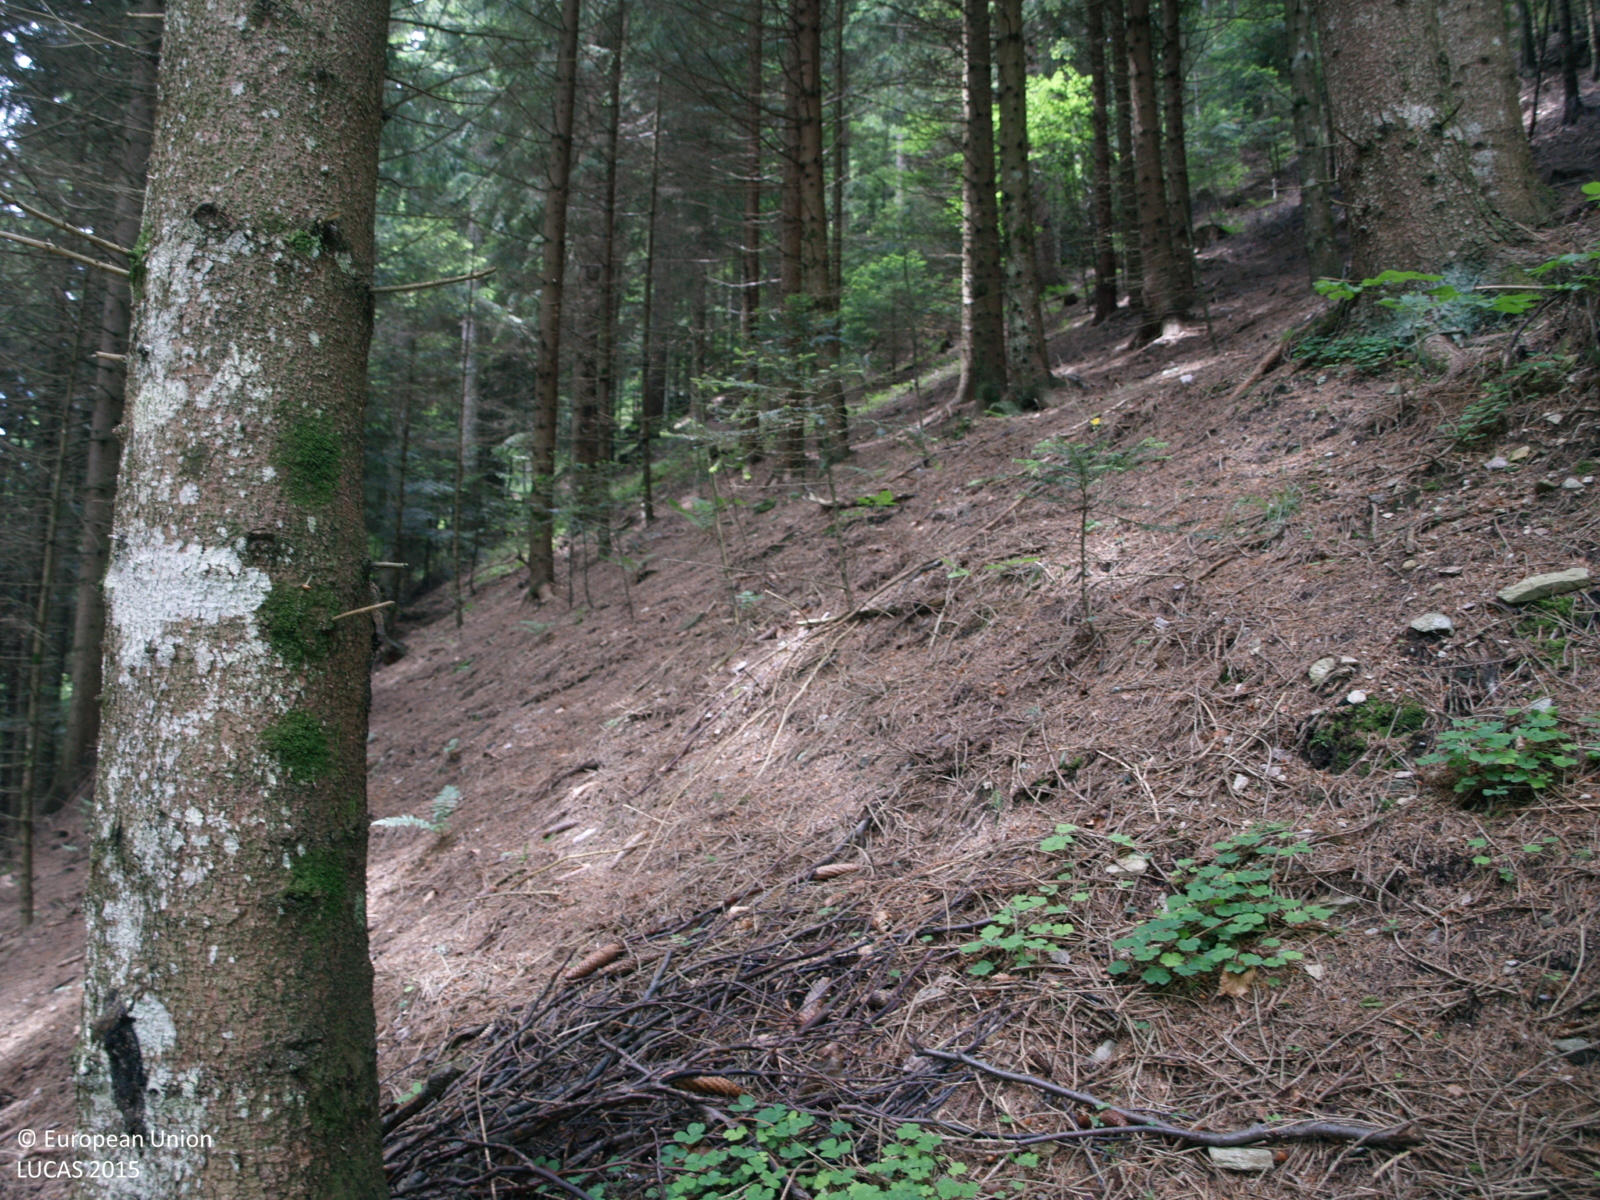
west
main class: Woodland
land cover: Spruce dominated coniferous woodland
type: alpine coniferous forest
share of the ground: > 75 %
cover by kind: coniferous forest trees 100 %
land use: Forestry
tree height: > 5 m
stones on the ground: < 10 %
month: May
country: IT
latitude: 46.3569
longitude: 11.6225
